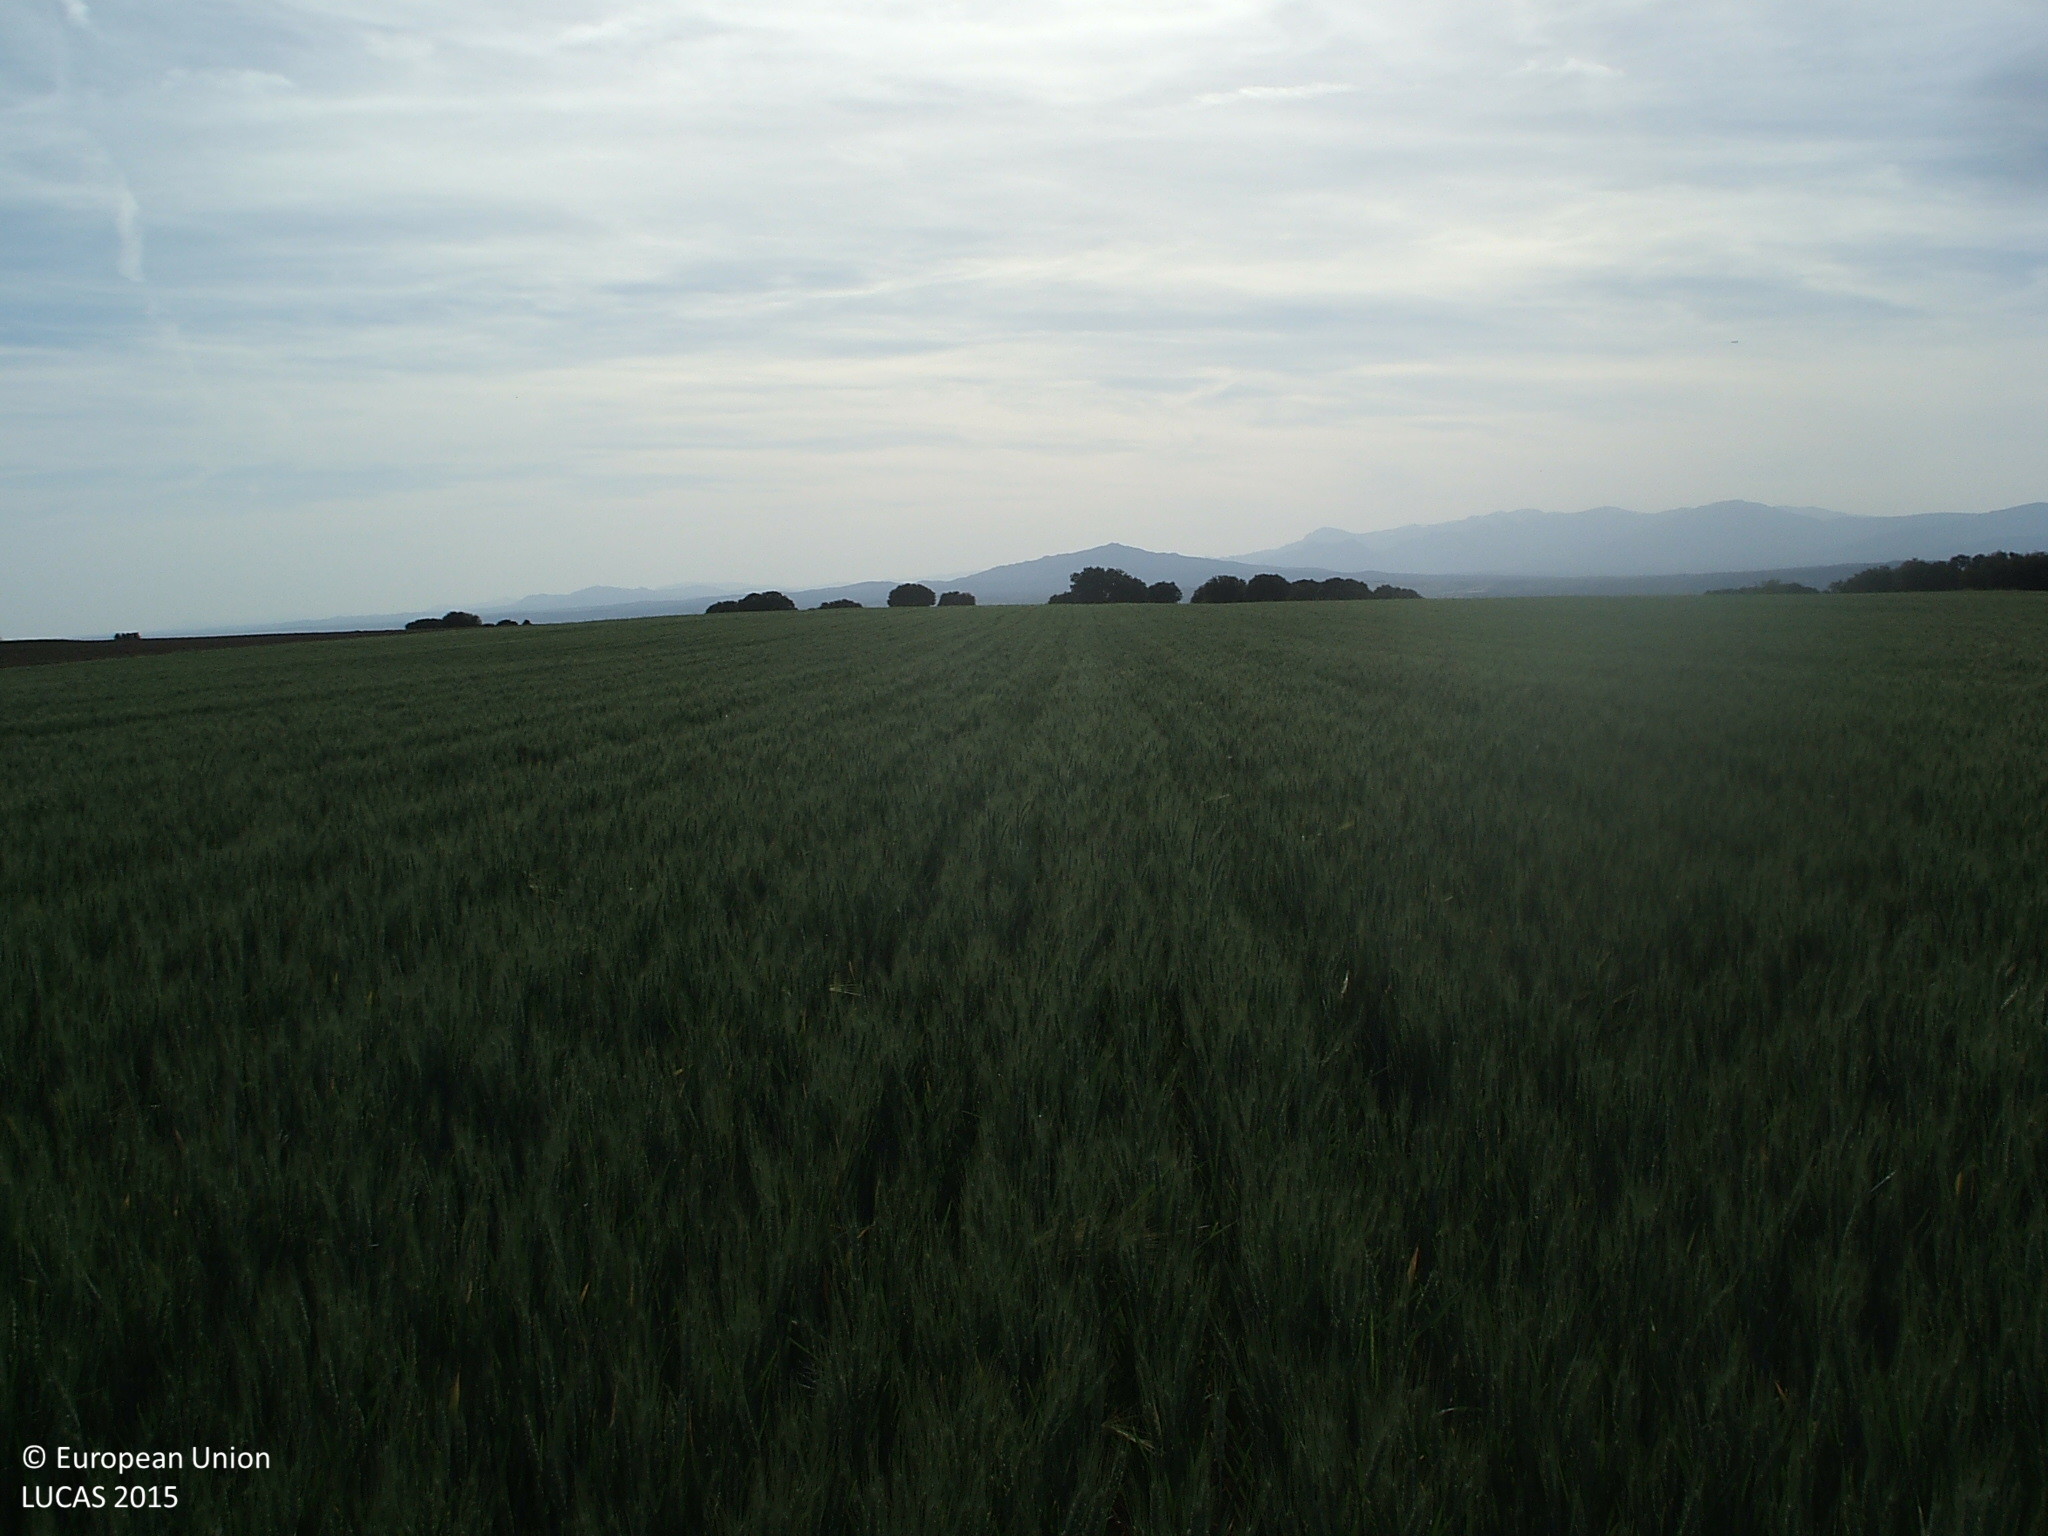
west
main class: Cropland
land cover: Common wheat
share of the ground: > 75 %
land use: Agriculture (excluding fallow land and kitchen gardens)
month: May
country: ES
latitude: 40.7308
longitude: -3.4295
